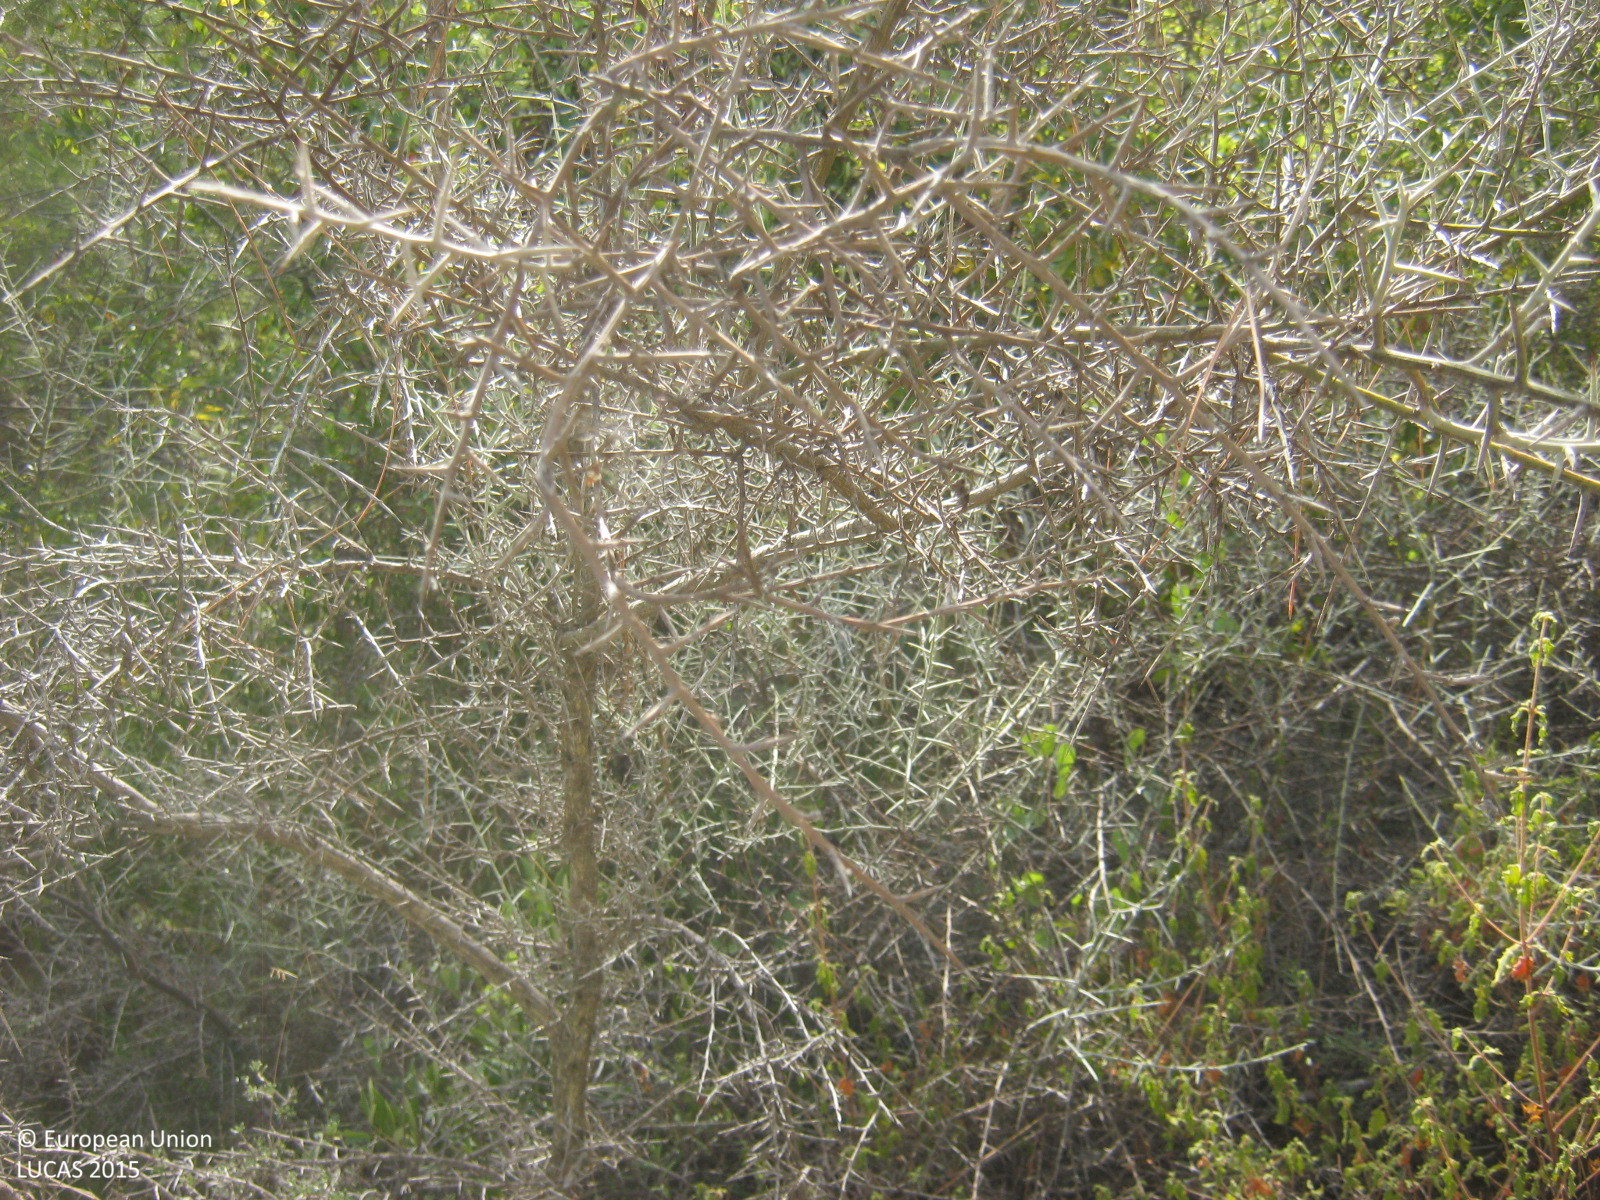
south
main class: Woodland
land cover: Pine dominated coniferous woodland
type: coniferous forest of the mediterranean region
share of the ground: > 75 %
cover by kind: coniferous forest trees 75 %, shrubs 15 %, herbaceous plants 5 %, unconsolidated bare surface 5 %
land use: Forestry
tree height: > 5 m
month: September
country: CY
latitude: 35.0492
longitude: 32.8073
